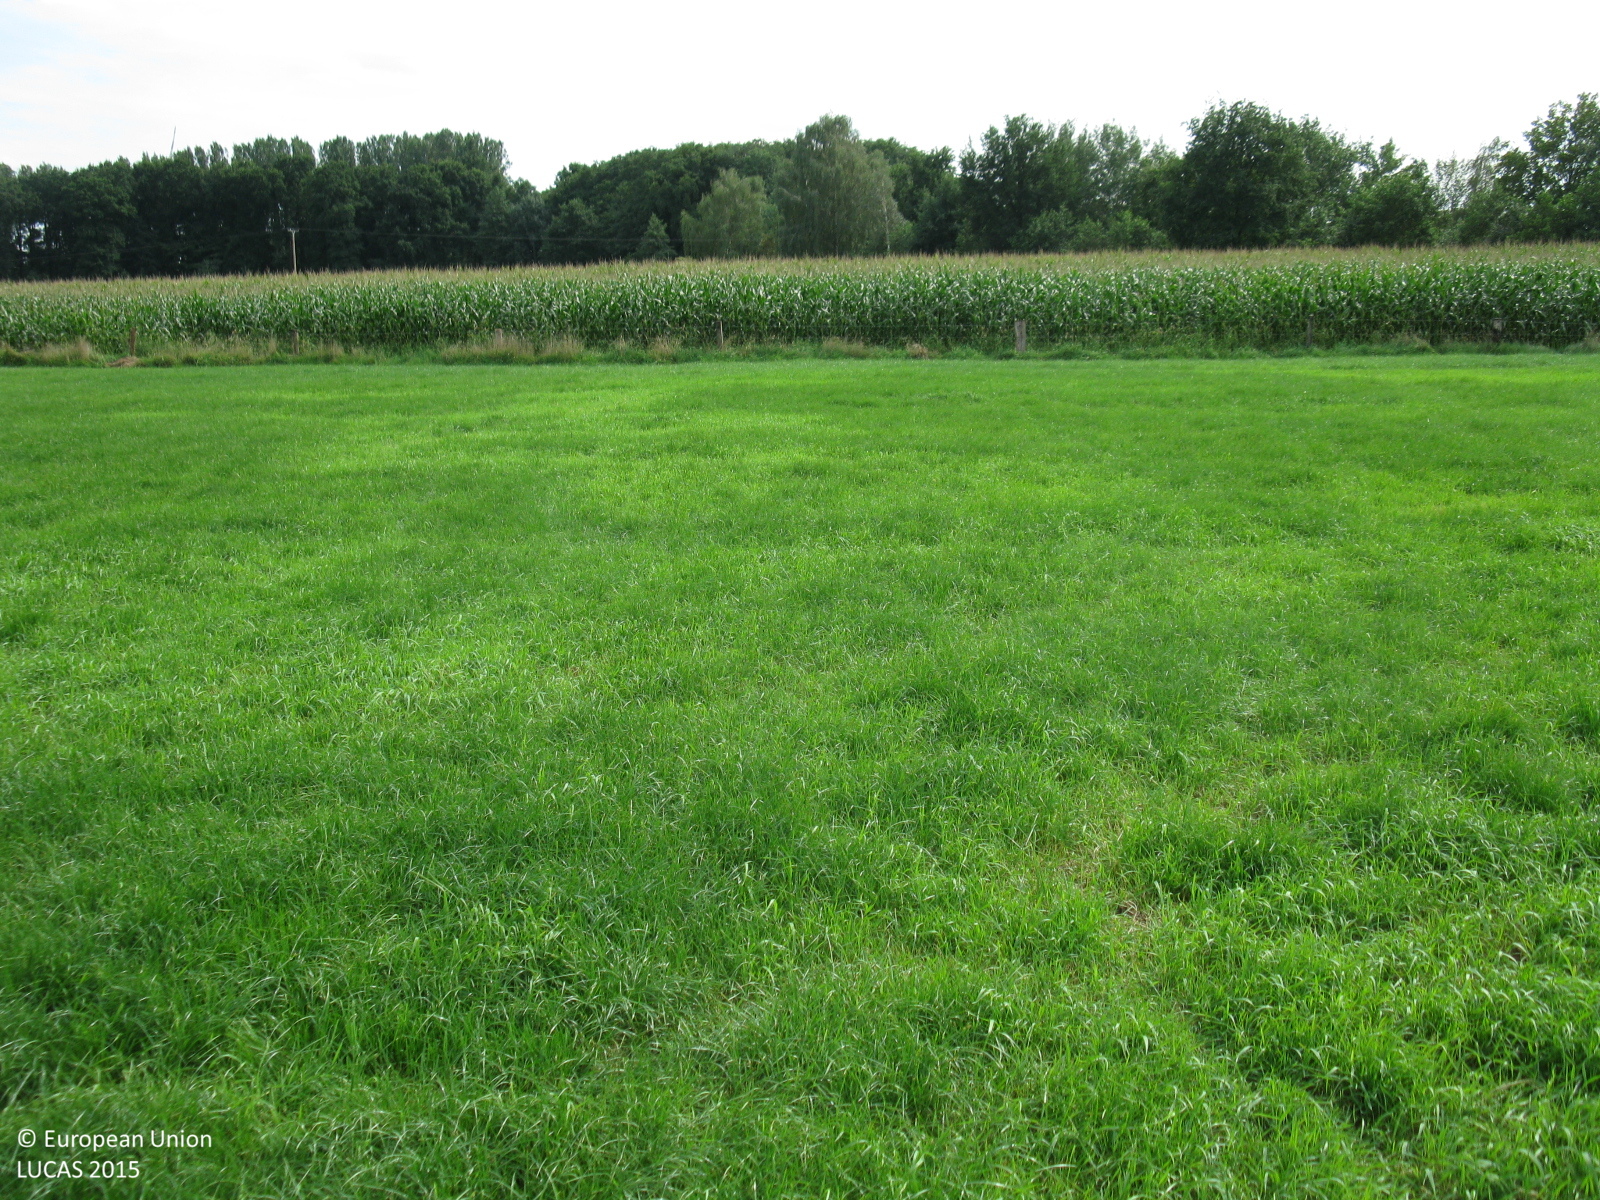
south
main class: Grassland
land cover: Grassland without tree/shrub cover
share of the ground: > 75 %
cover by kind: herbaceous plants 100 %
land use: Agriculture (excluding fallow land and kitchen gardens)
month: August
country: DE
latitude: 51.8164
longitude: 6.9391
